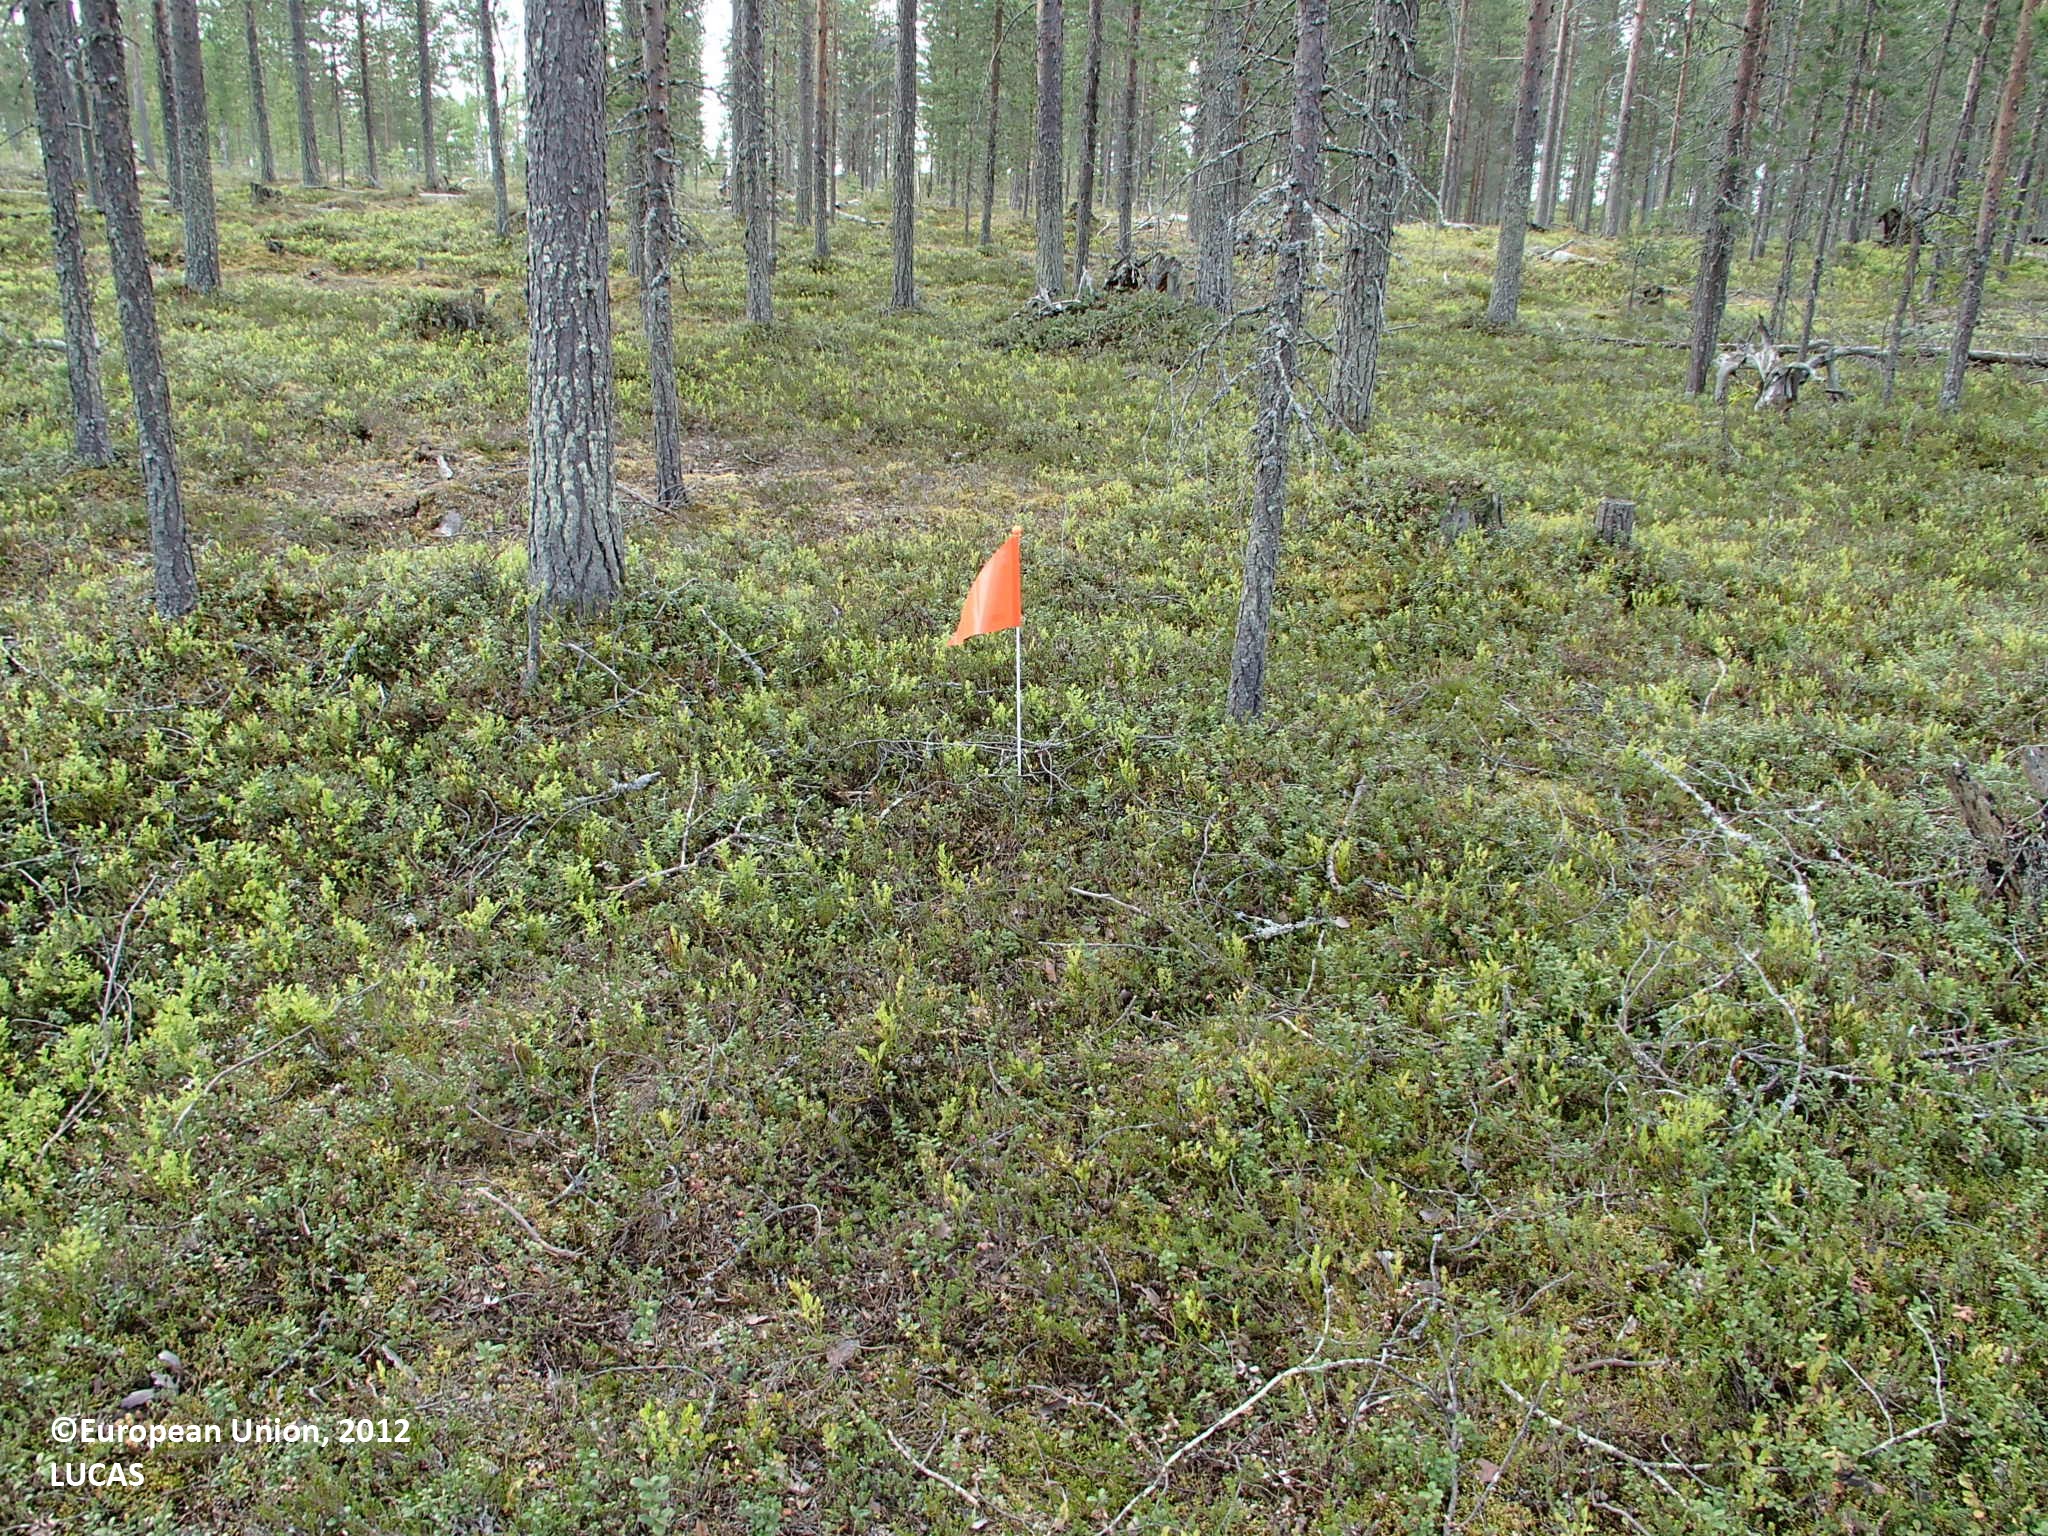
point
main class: Woodland
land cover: Pine dominated coniferous woodland
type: boreal forest
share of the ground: > 75 %
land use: Forestry
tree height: > 5 m
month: June
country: FI
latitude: 66.4565
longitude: 27.0863
